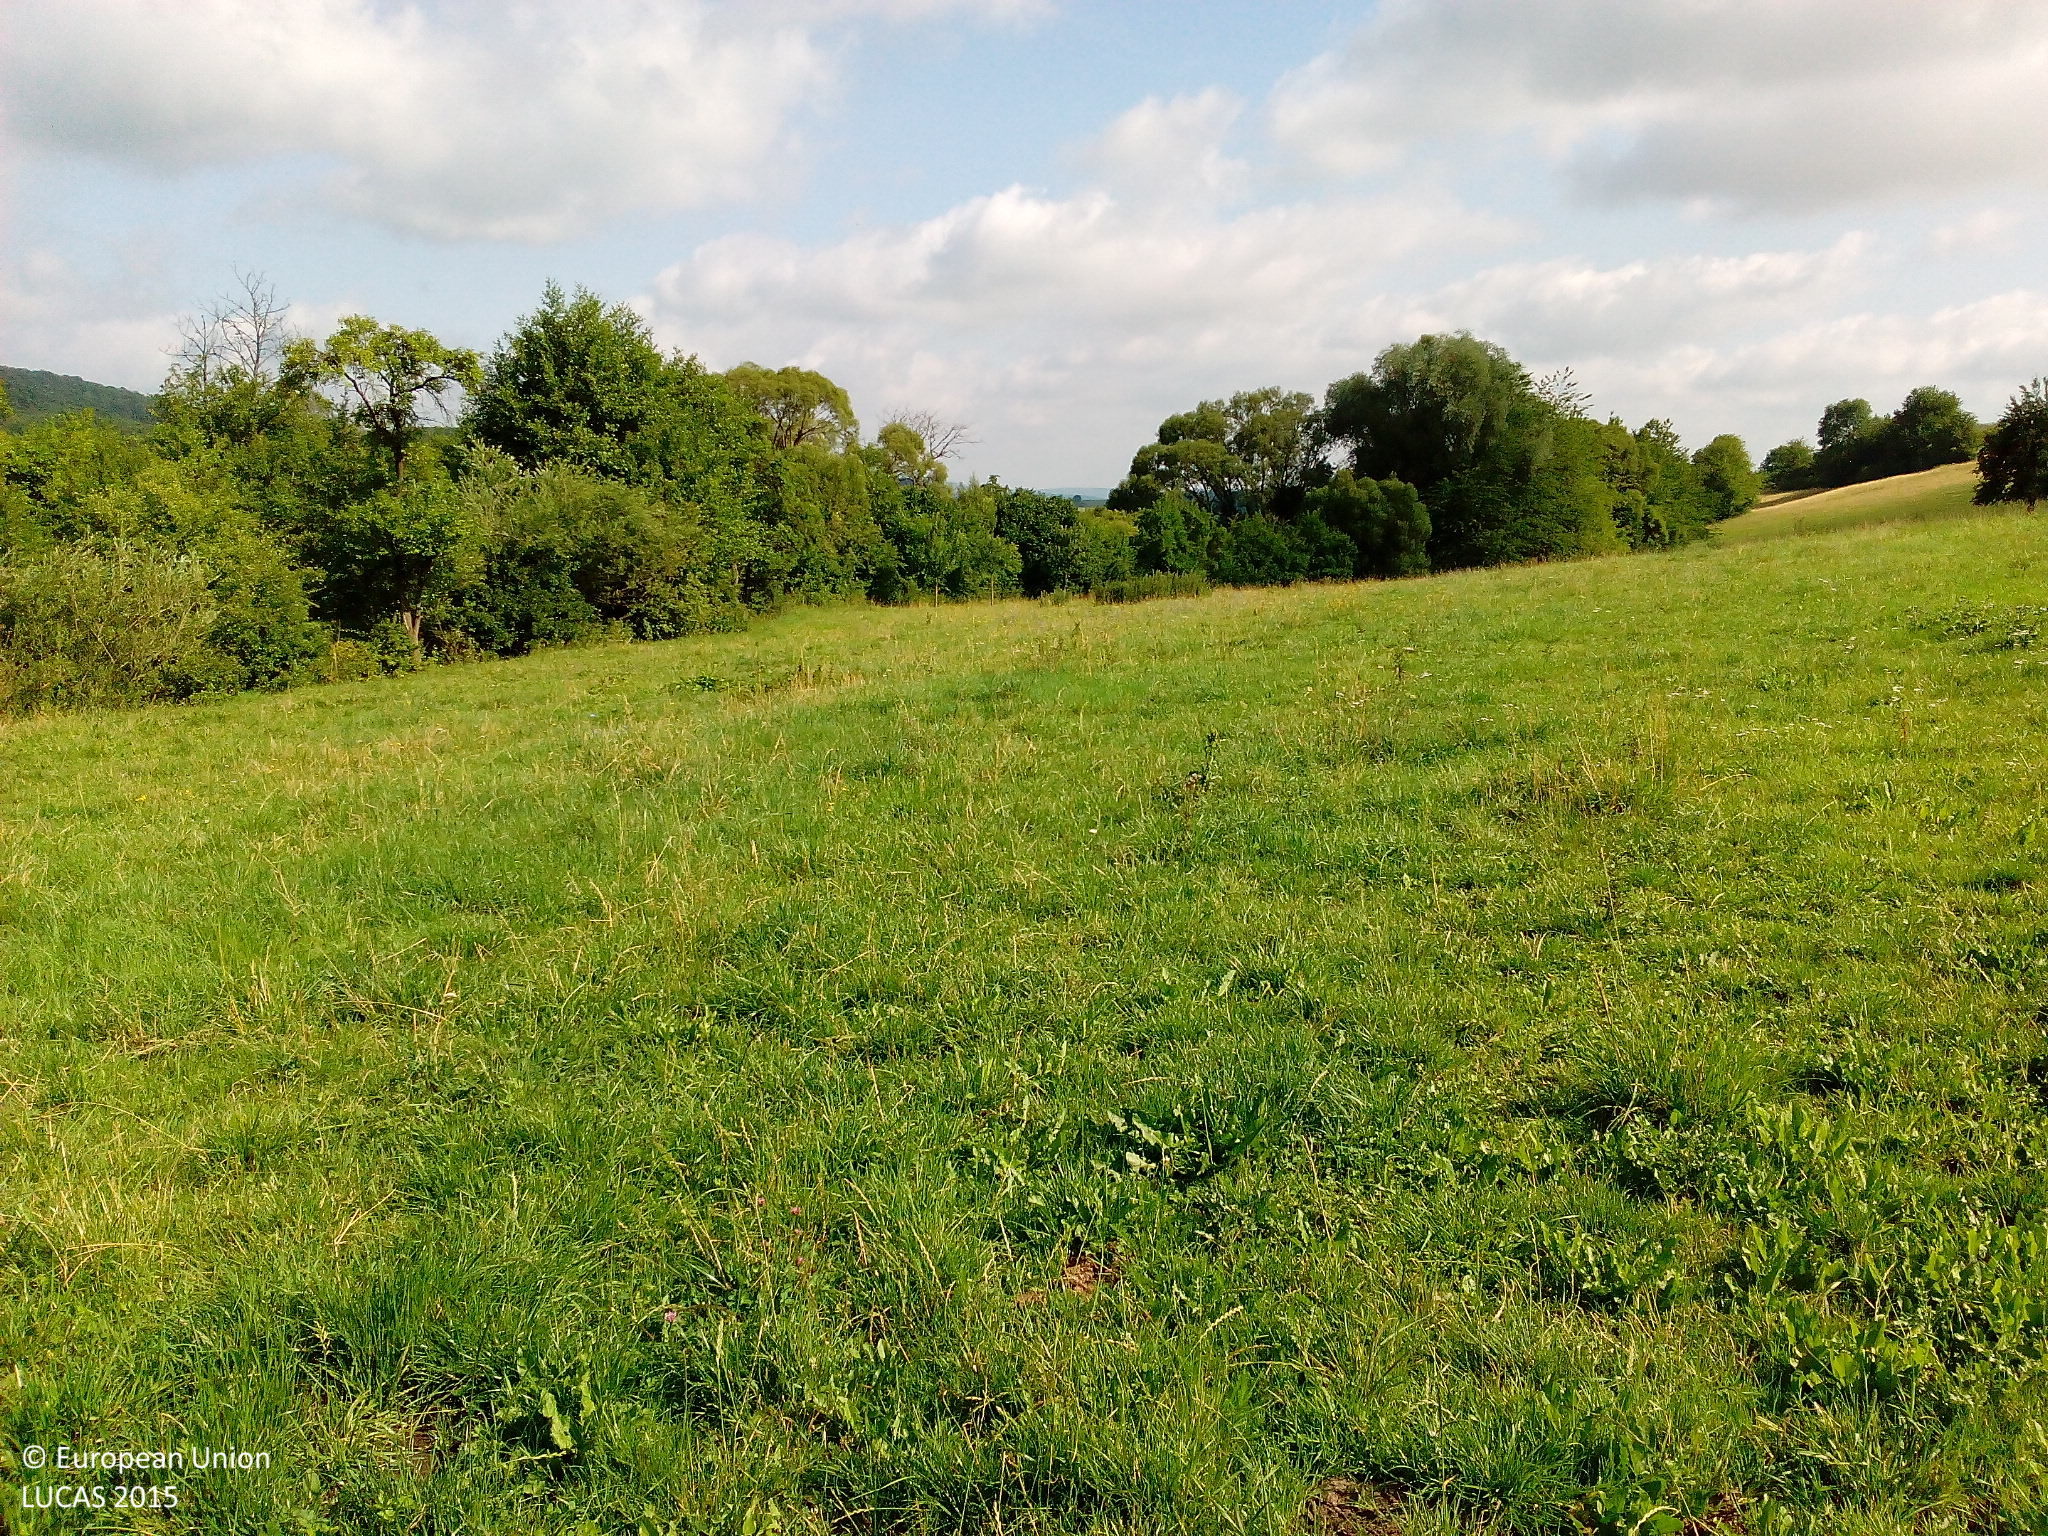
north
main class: Grassland
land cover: Grassland without tree/shrub cover
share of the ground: > 75 %
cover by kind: herbaceous plants 100 %
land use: Agriculture (excluding fallow land and kitchen gardens)
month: July
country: DE
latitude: 50.6517
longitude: 9.9010
